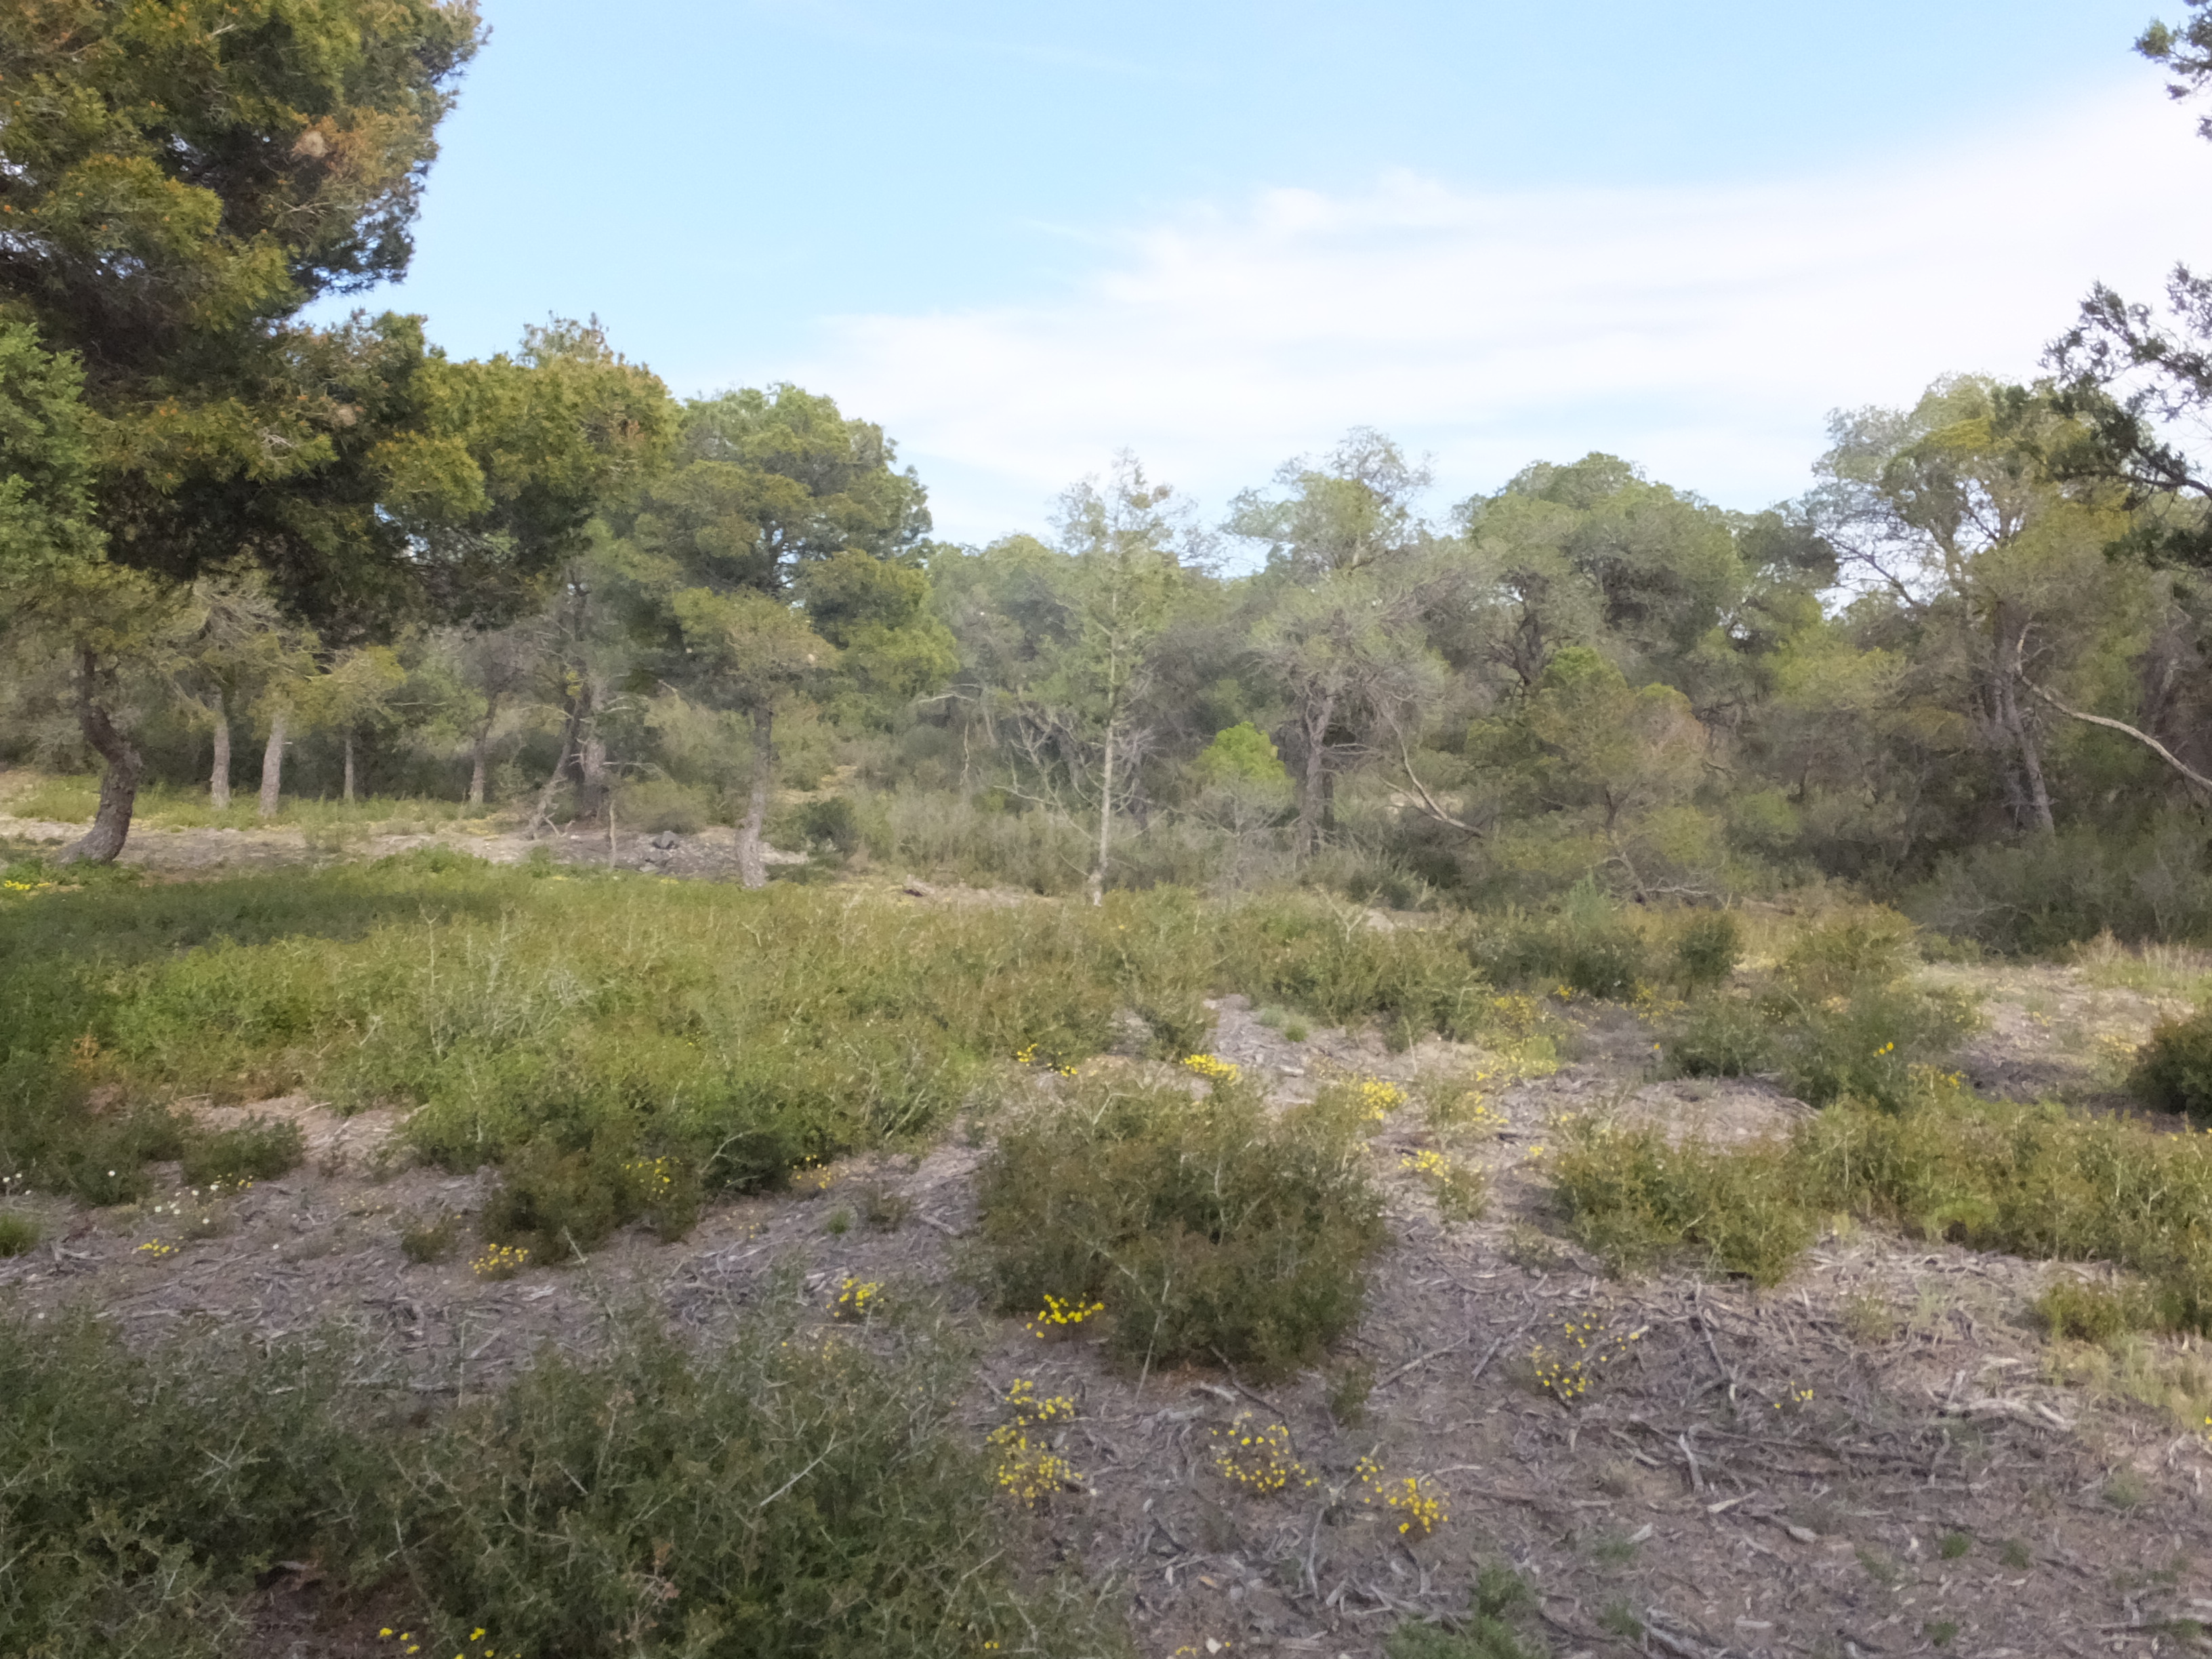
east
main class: Woodland
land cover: Pine dominated coniferous woodland
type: coniferous forest of the mediterranean region
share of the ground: 50 - 75 %
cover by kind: coniferous forest trees 70 %, broadleaved forest trees 15 %, shrubs 10 %, herbaceous plants 5 %
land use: Forestry
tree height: > 5 m
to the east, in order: Pine dominated coniferous woodland
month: April
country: ES
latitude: 41.6153
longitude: -0.3262
